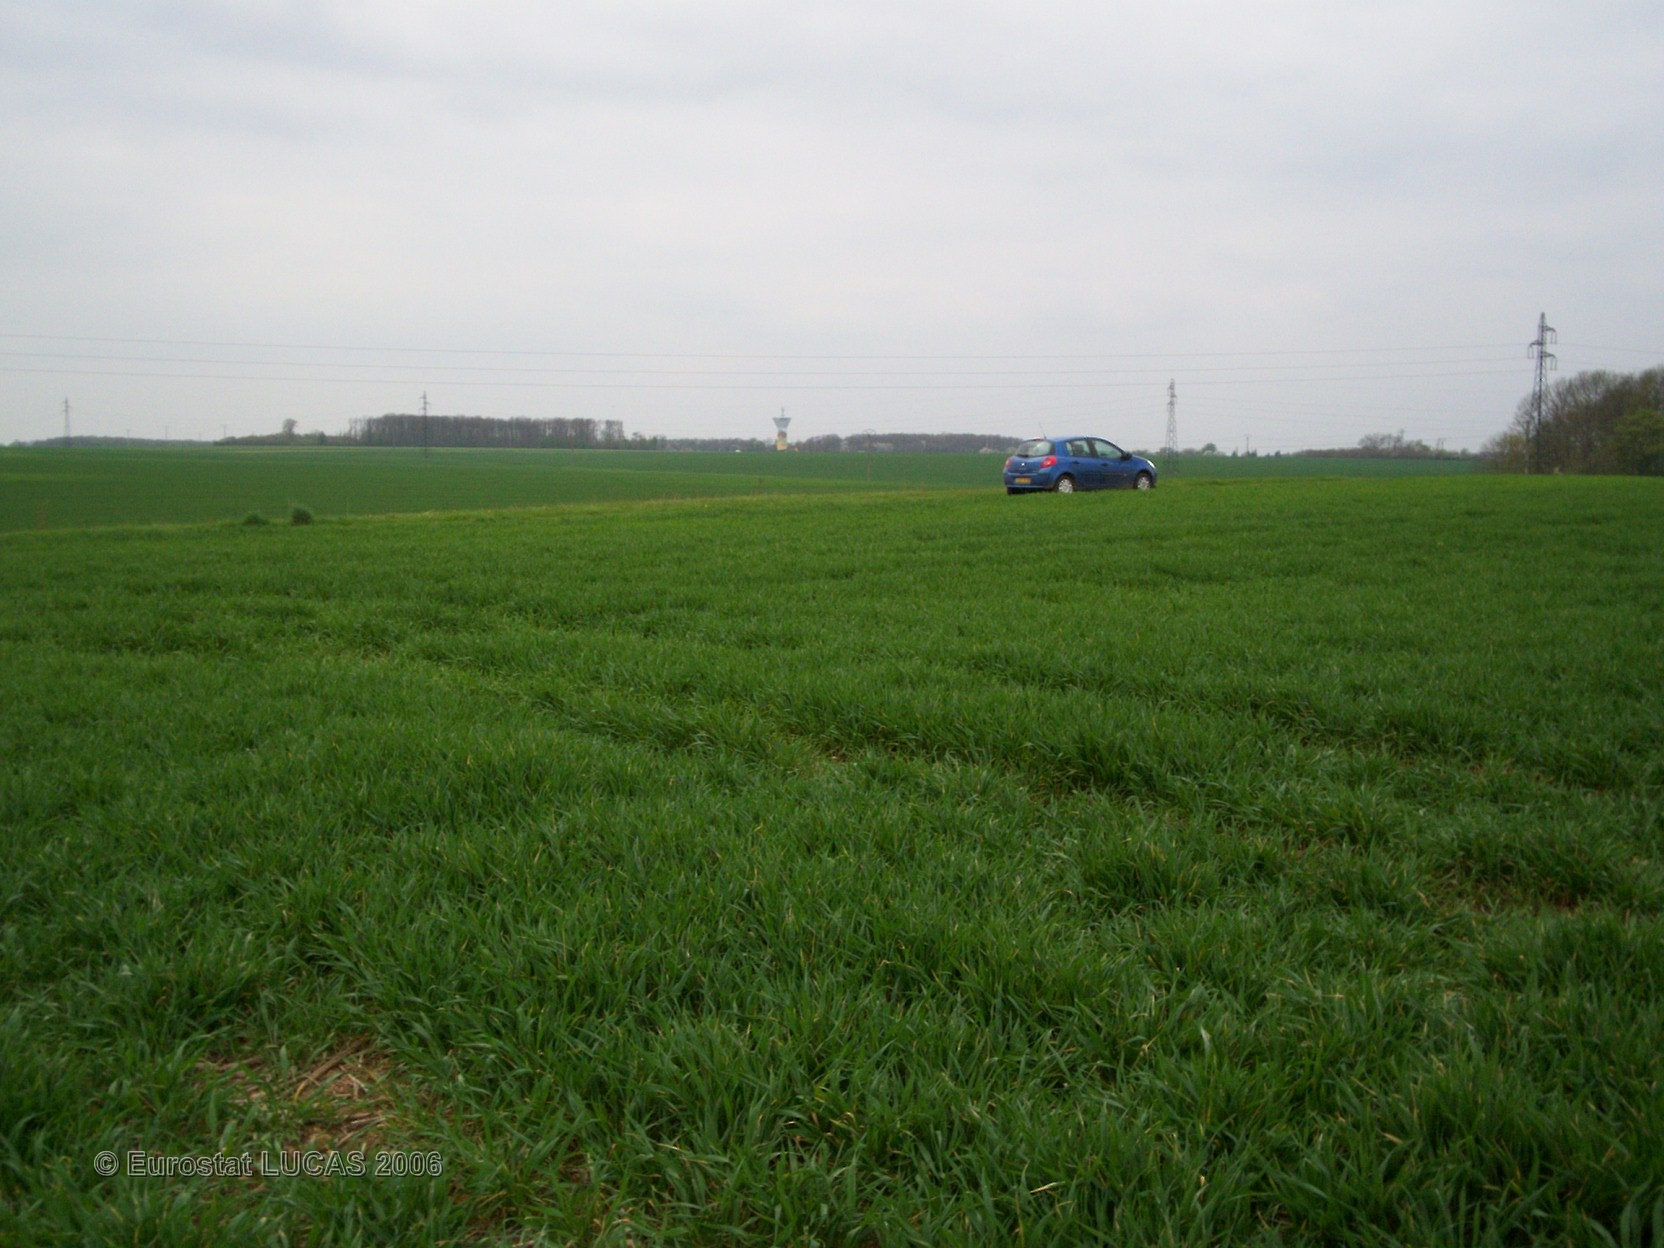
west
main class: Cropland
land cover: Common wheat
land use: Agriculture (excluding fallow land and kitchen gardens)
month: April
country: FR
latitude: 48.8568
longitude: 1.0791
